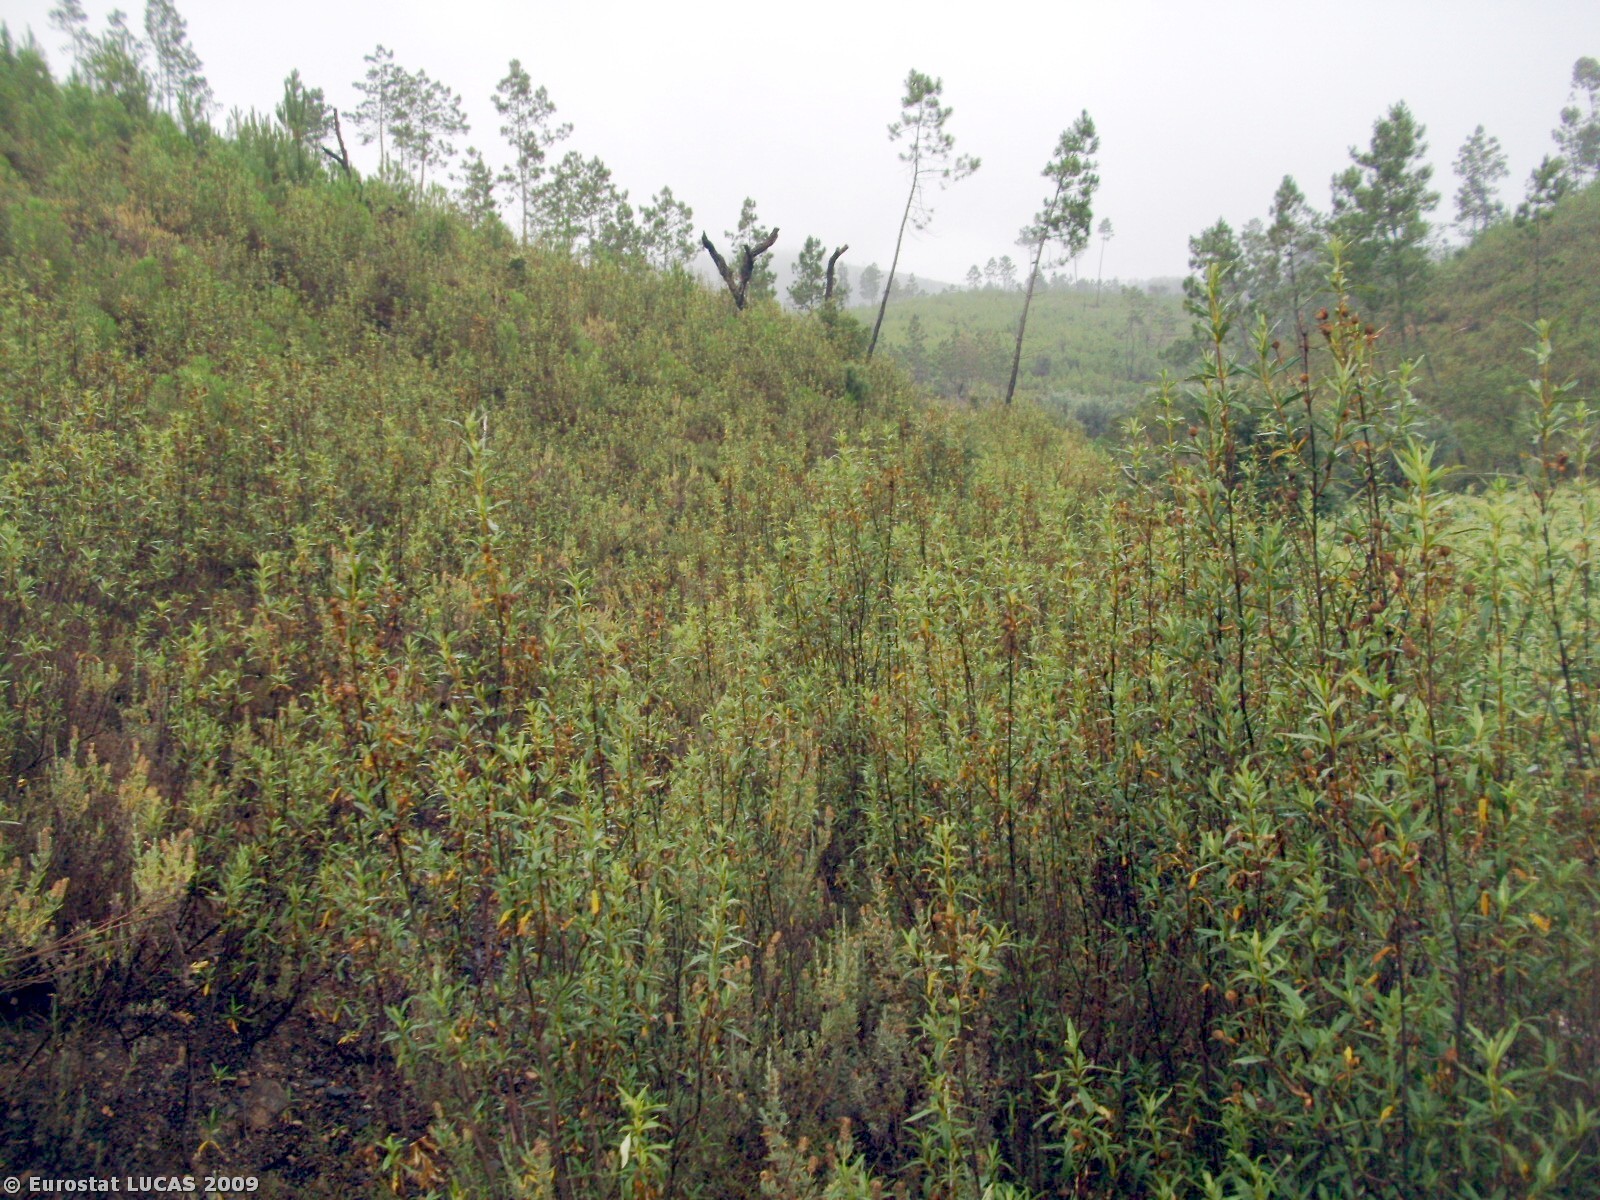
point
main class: Shrubland
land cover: Shrubland with sparse tree cover
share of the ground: > 75 %
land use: Forestry
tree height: > 5 m
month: July
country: PT
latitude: 39.6812
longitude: -8.0781
